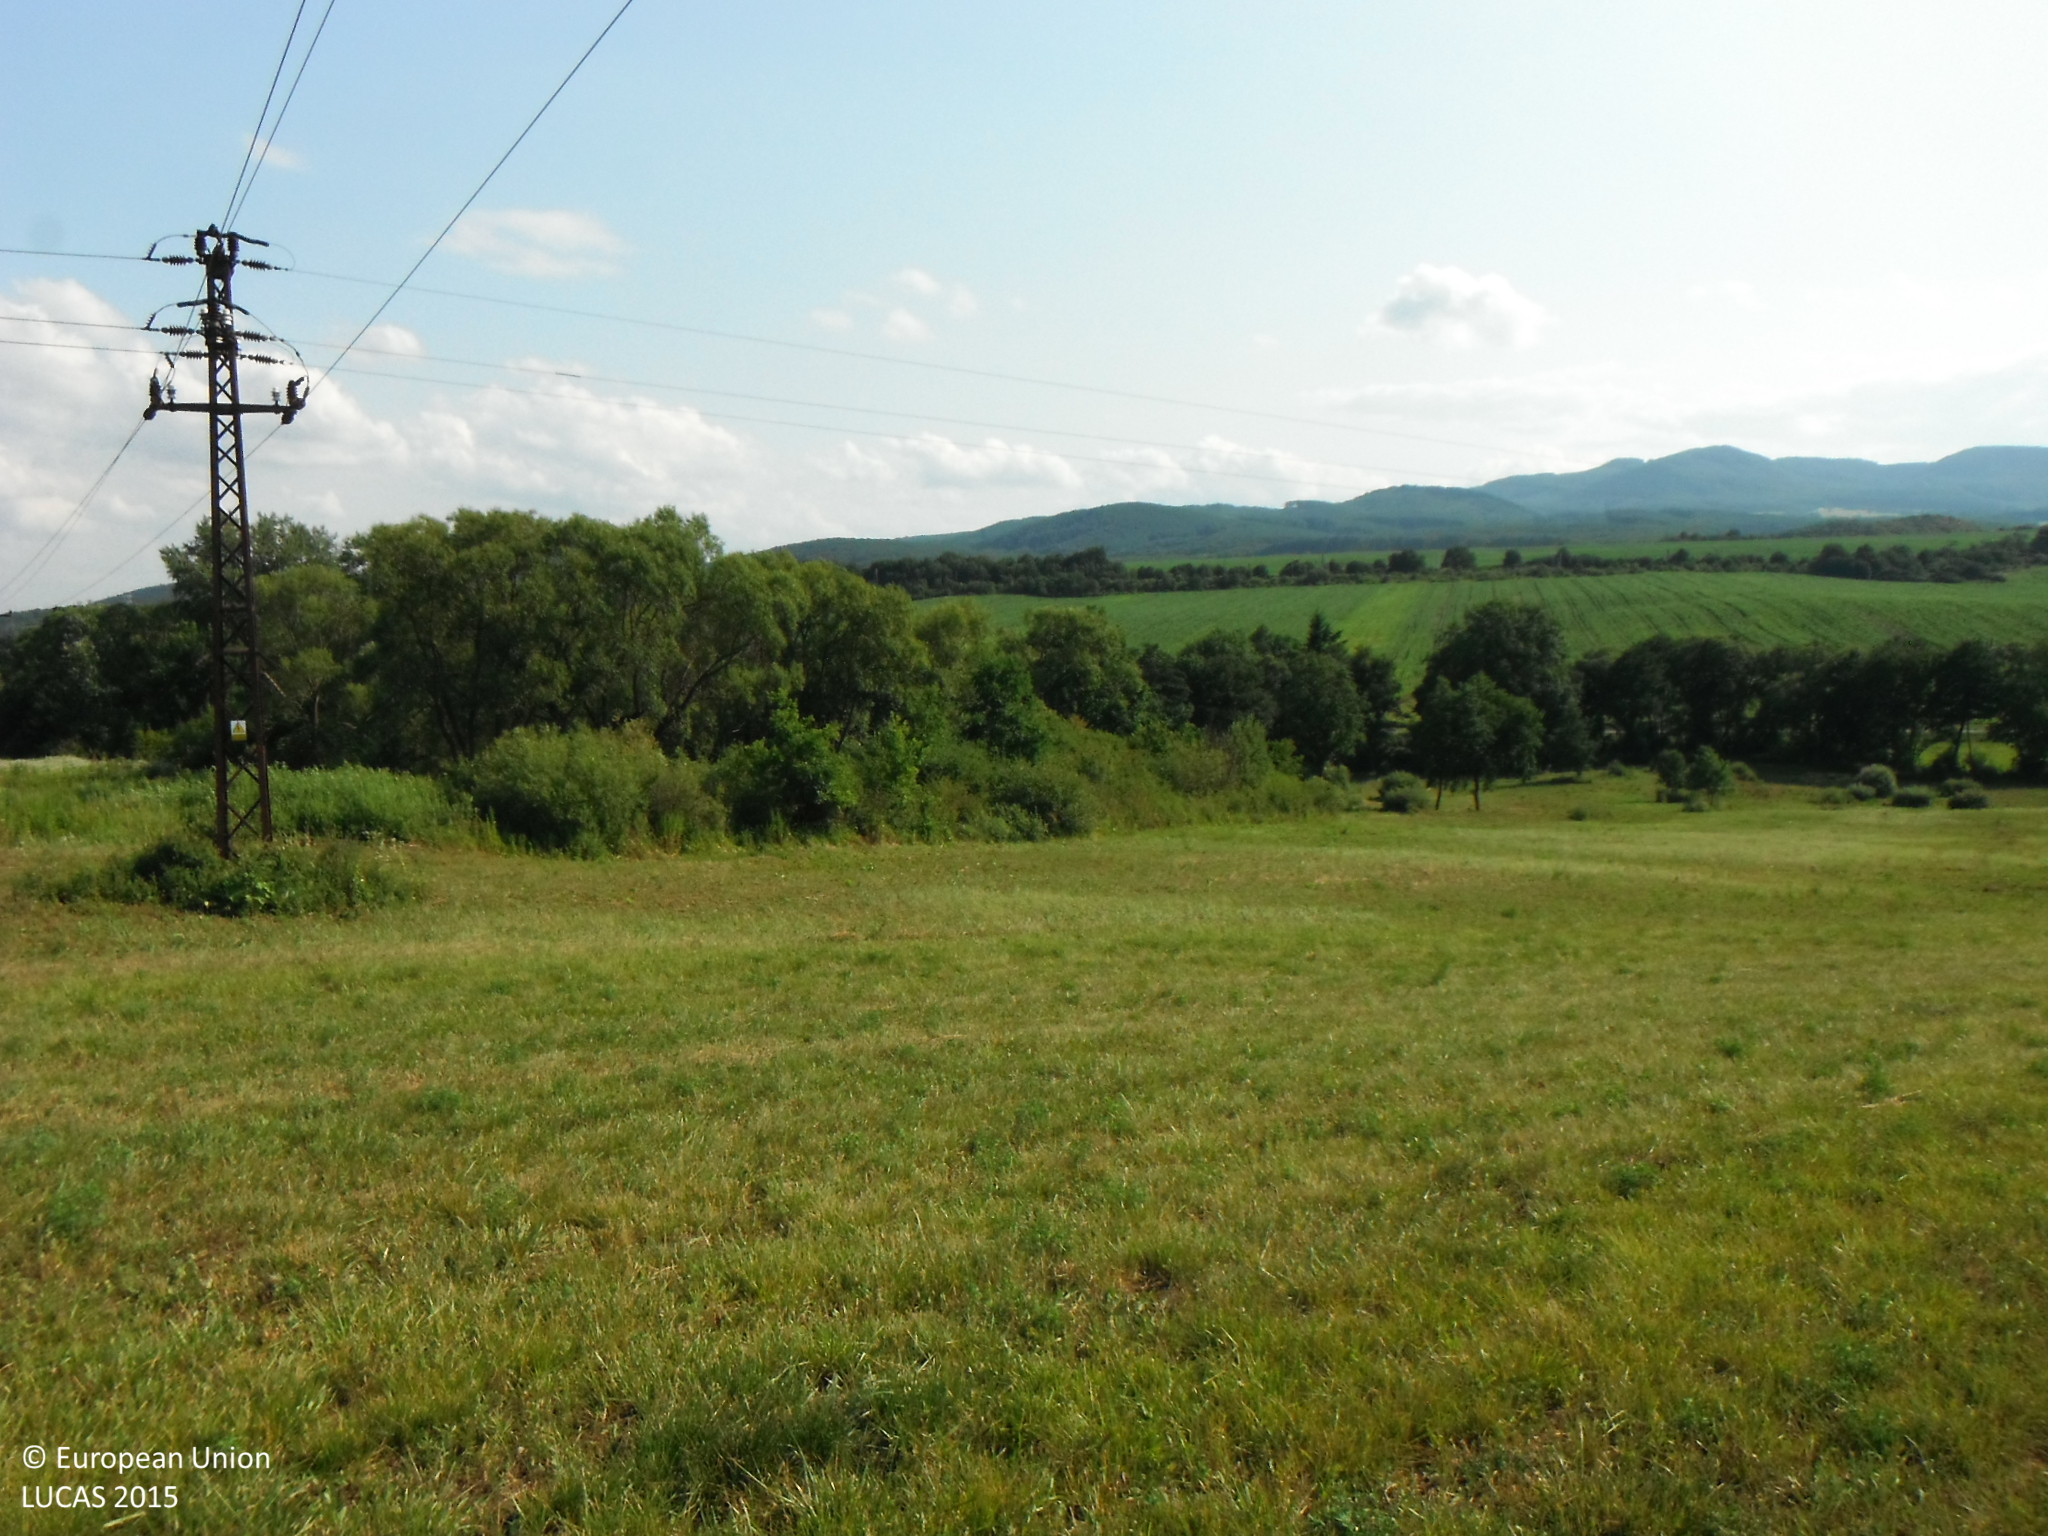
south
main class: Cropland
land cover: Other leguminous and mixtures for fodder
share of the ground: > 75 %
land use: Agriculture (excluding fallow land and kitchen gardens)
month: July
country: SK
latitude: 48.6357
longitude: 21.5143
